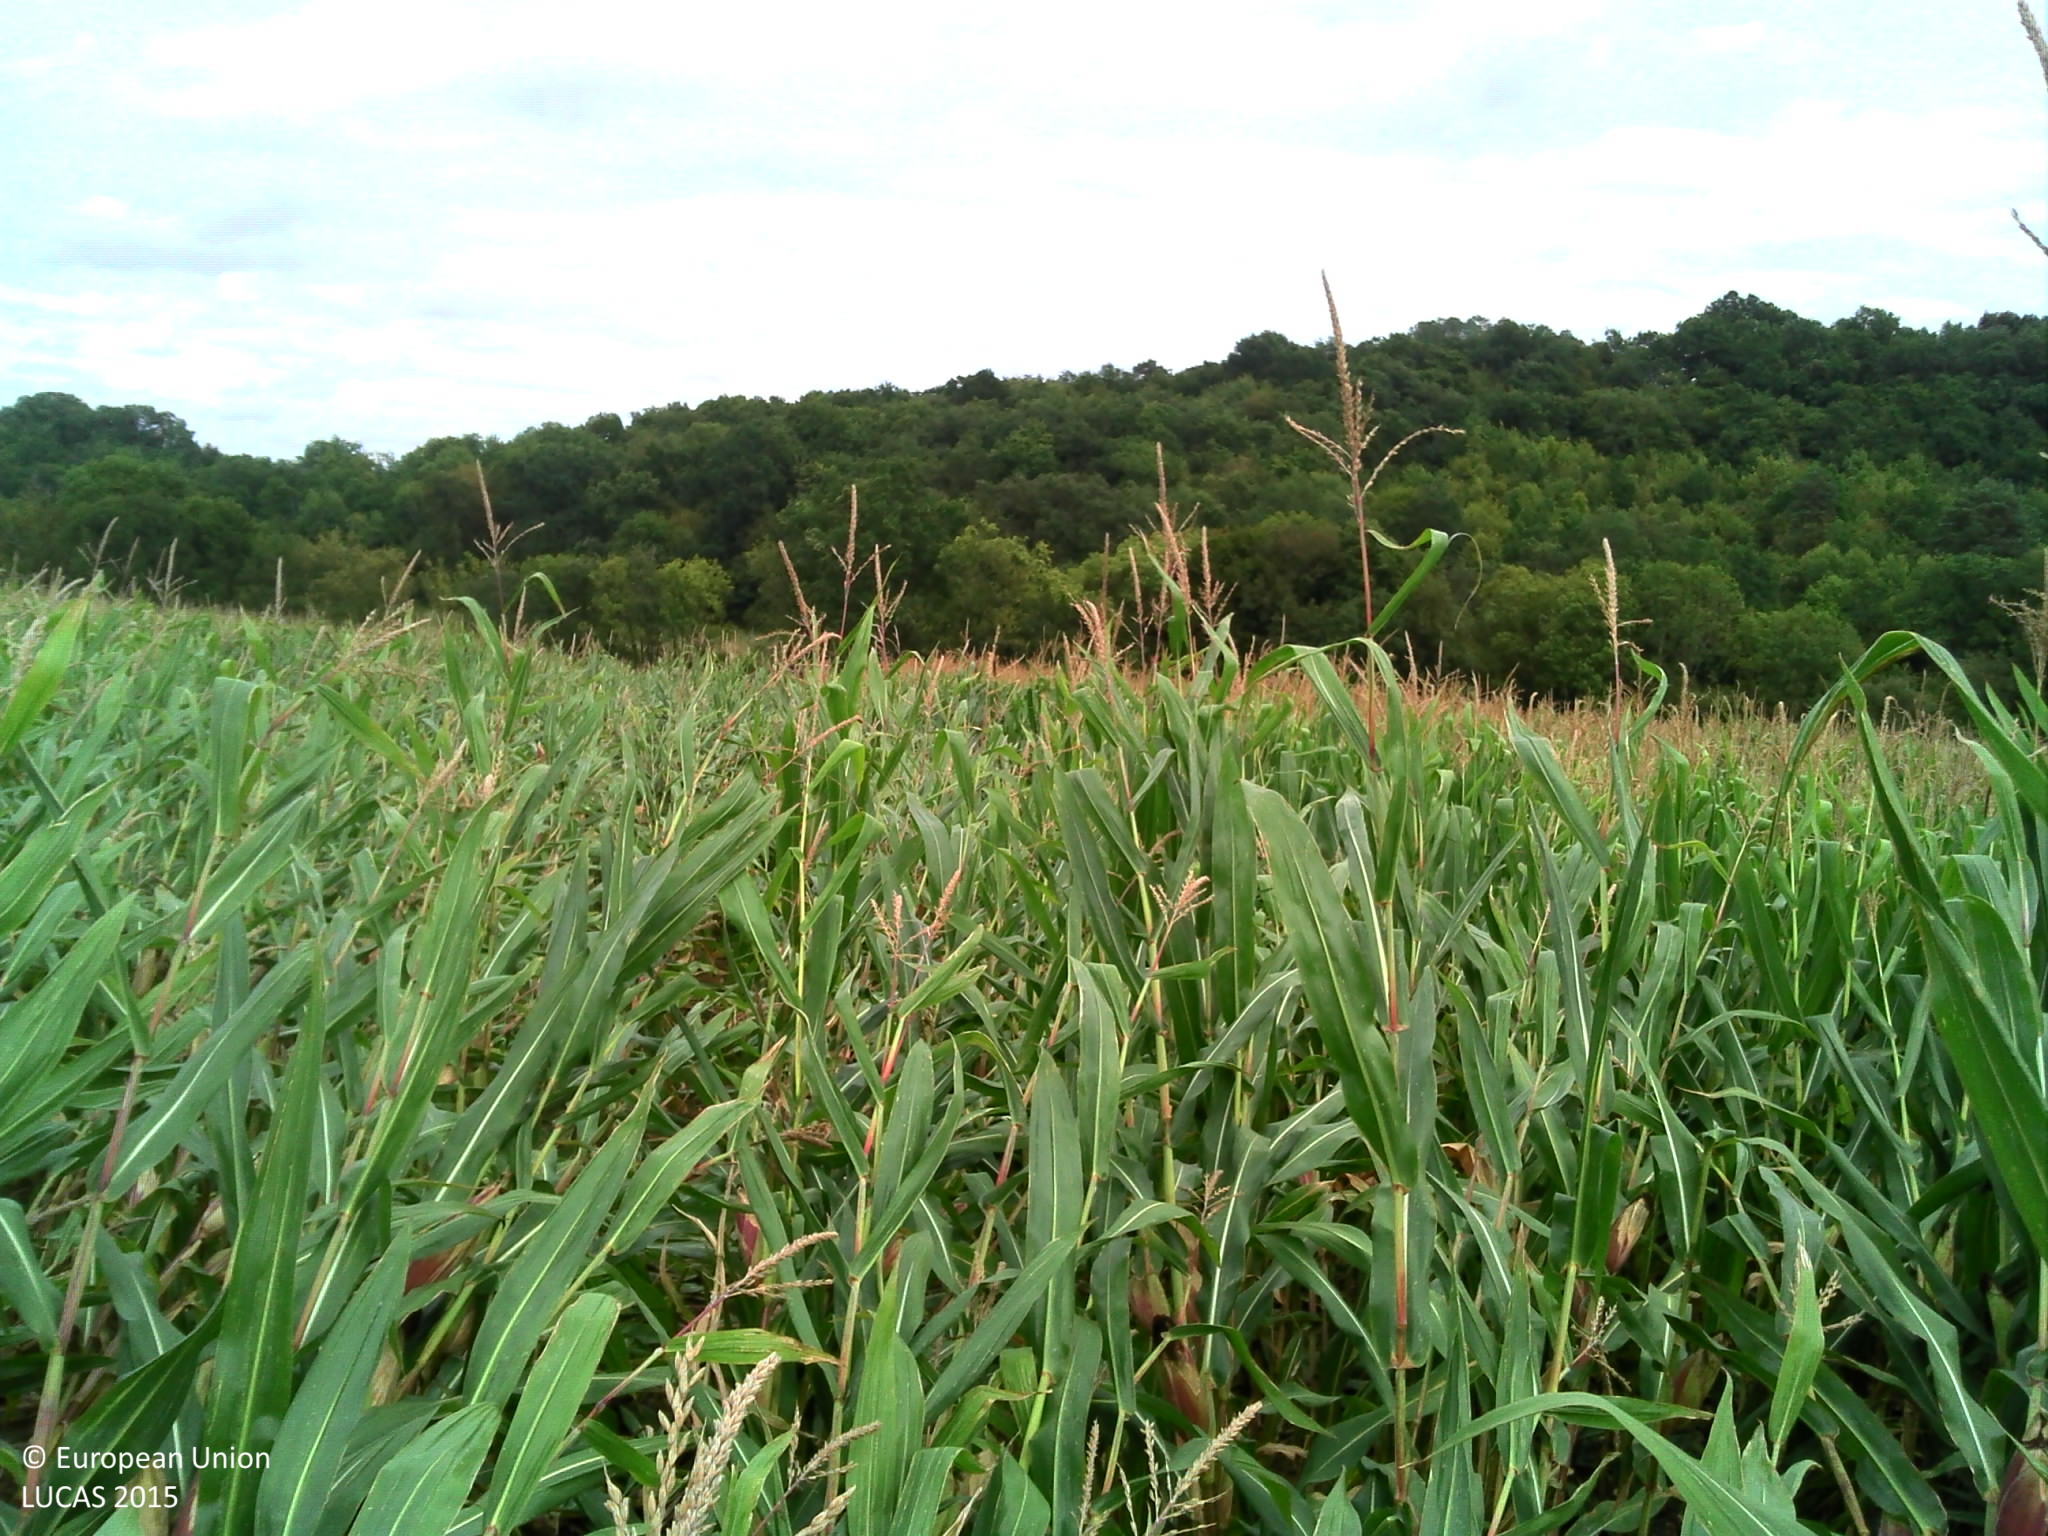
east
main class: Cropland
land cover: Maize
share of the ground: > 75 %
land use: Agriculture (excluding fallow land and kitchen gardens)
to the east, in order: Maize; Grassland without tree/shrub cover; Rivers and streams; Broadleaved woodland; Grassland without tree/shrub cover; Maize
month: September
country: FR
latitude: 43.4850
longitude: -0.1825
